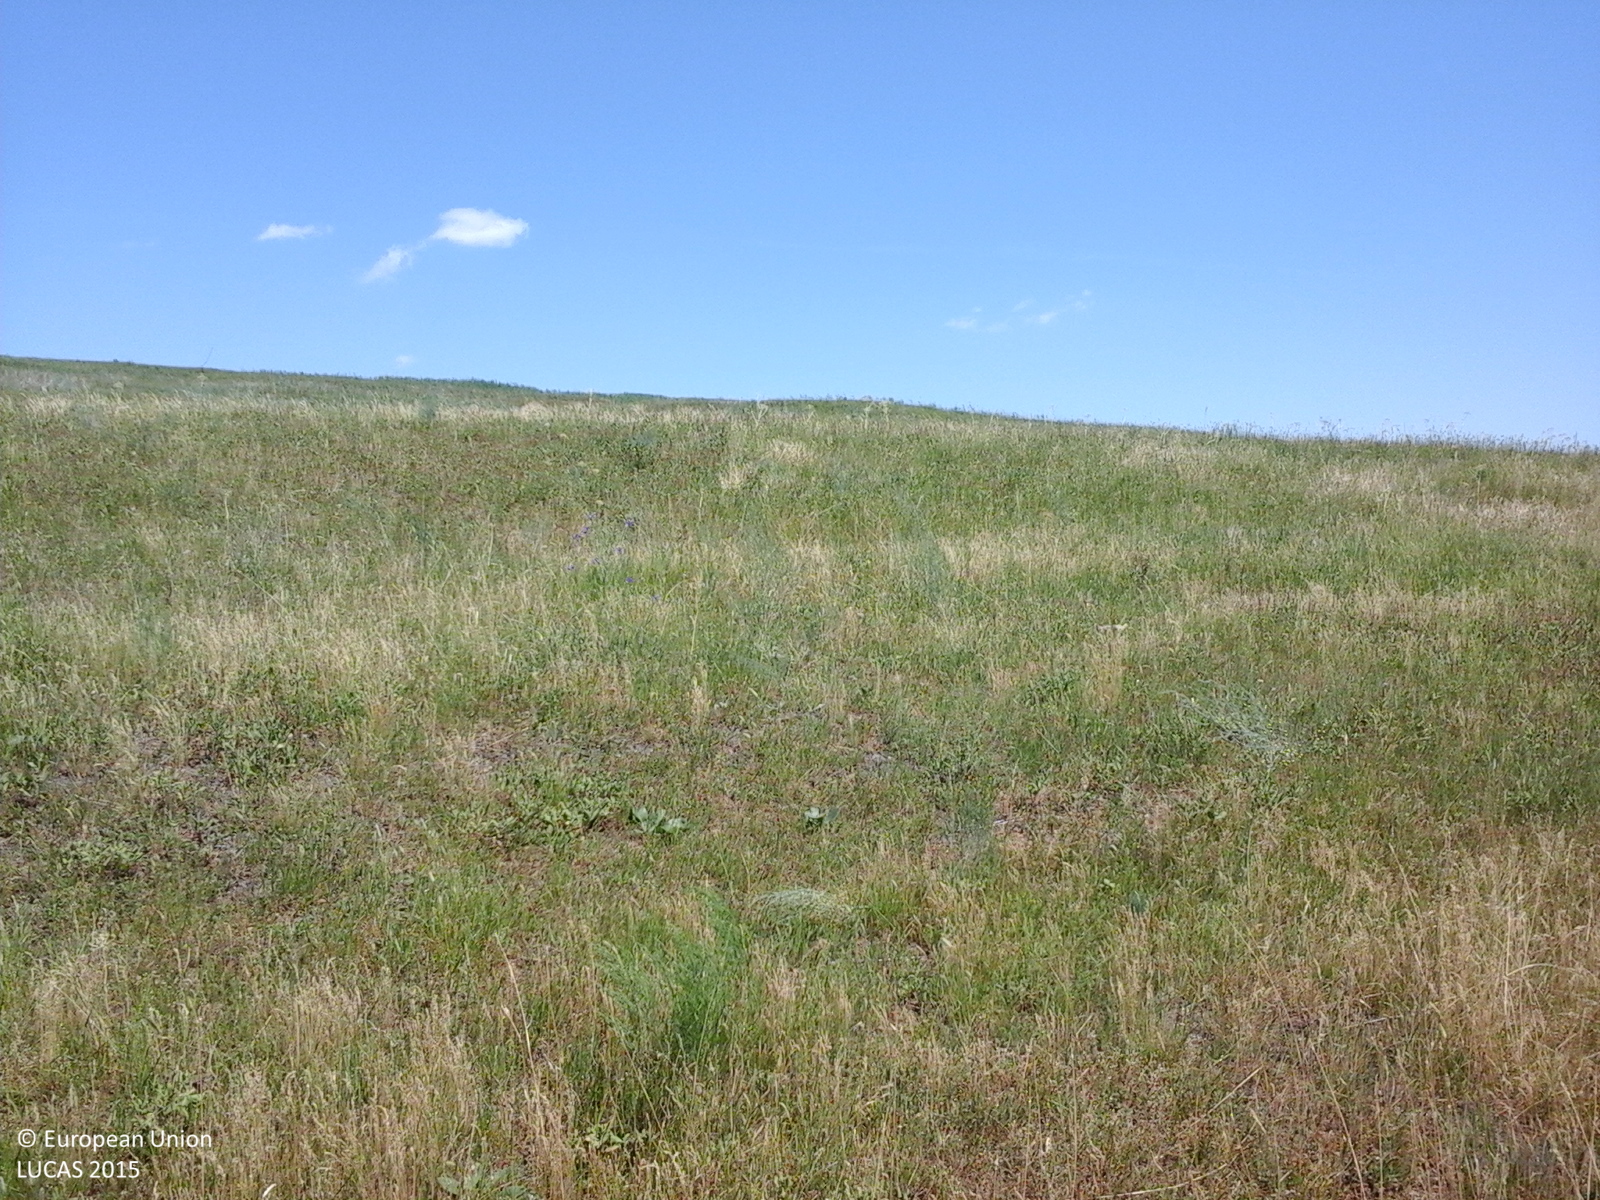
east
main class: Grassland
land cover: Grassland without tree/shrub cover
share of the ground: > 75 %
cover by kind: herbaceous plants 100 %
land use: Agriculture (excluding fallow land and kitchen gardens)
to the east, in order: Grassland without tree/shrub cover; Spontaneously vegetated surfaces
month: June
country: RO
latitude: 47.4833
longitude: 26.9696
